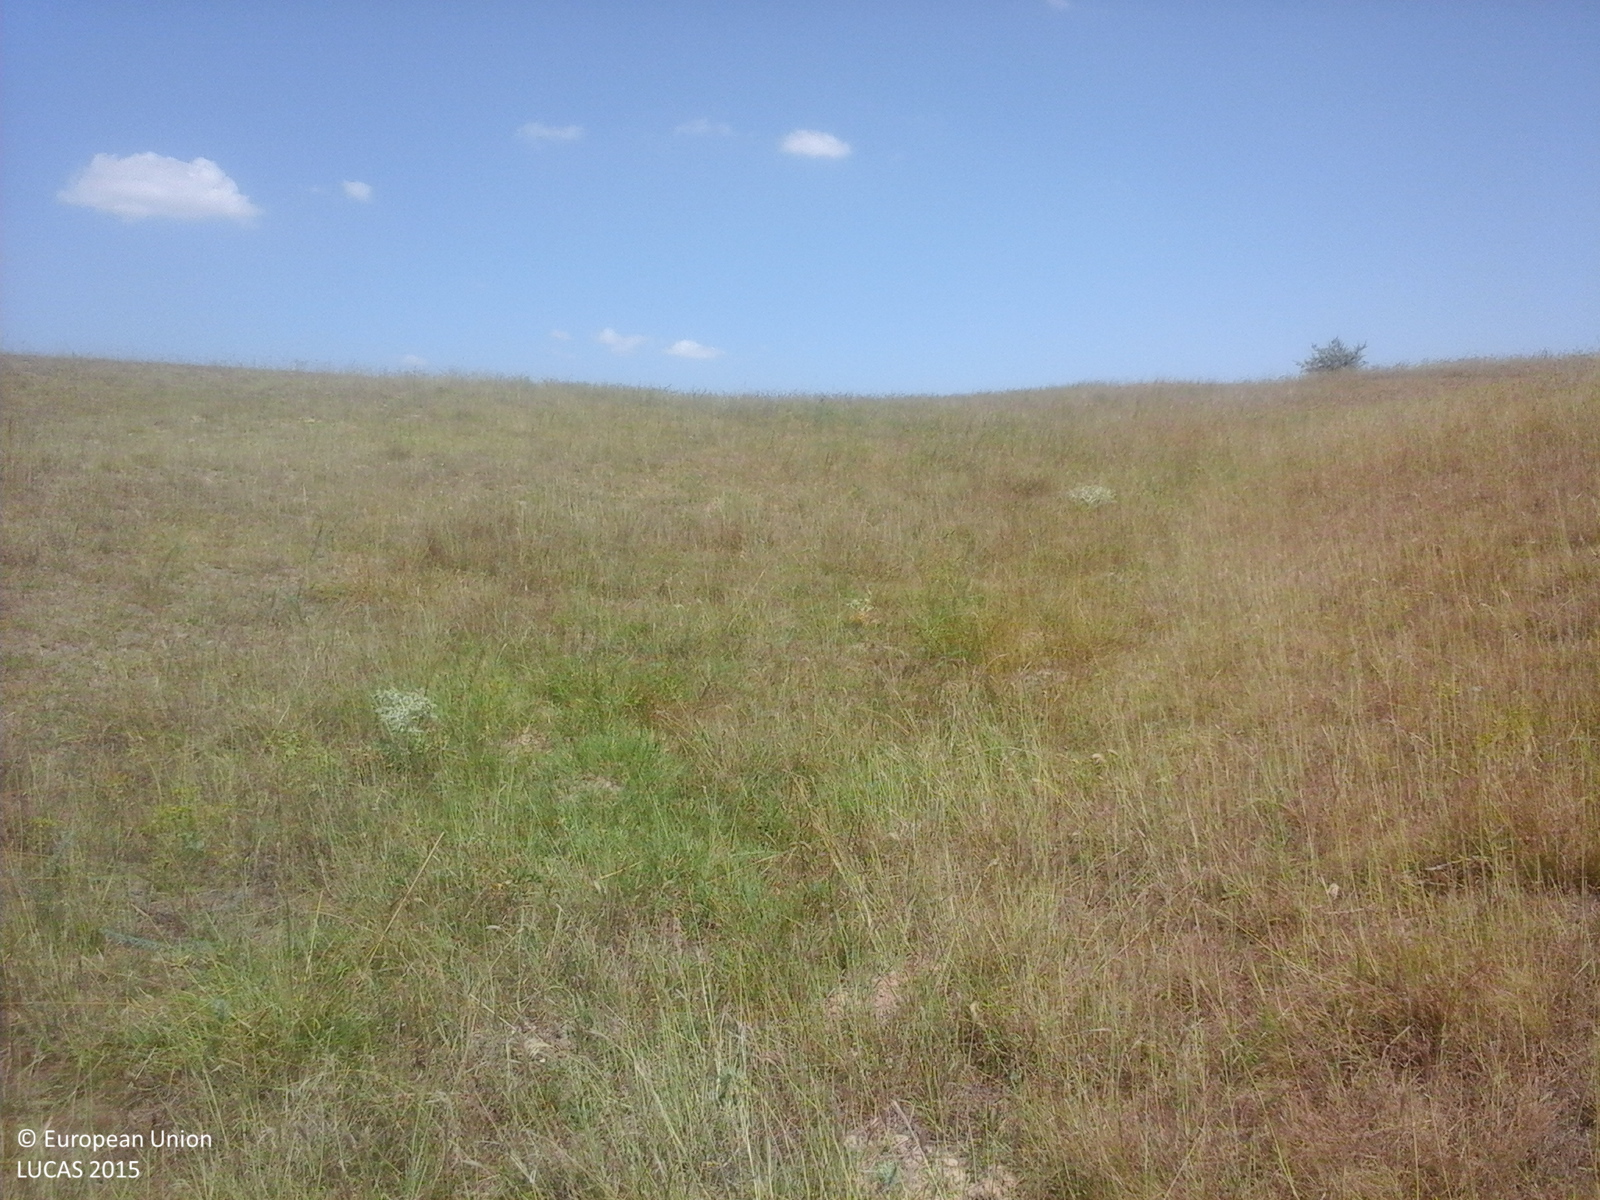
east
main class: Grassland
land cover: Grassland without tree/shrub cover
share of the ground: > 75 %
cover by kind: herbaceous plants 100 %
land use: Agriculture (excluding fallow land and kitchen gardens)
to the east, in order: Grassland without tree/shrub cover; Common wheat
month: August
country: RO
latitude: 44.4939
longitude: 28.1066
